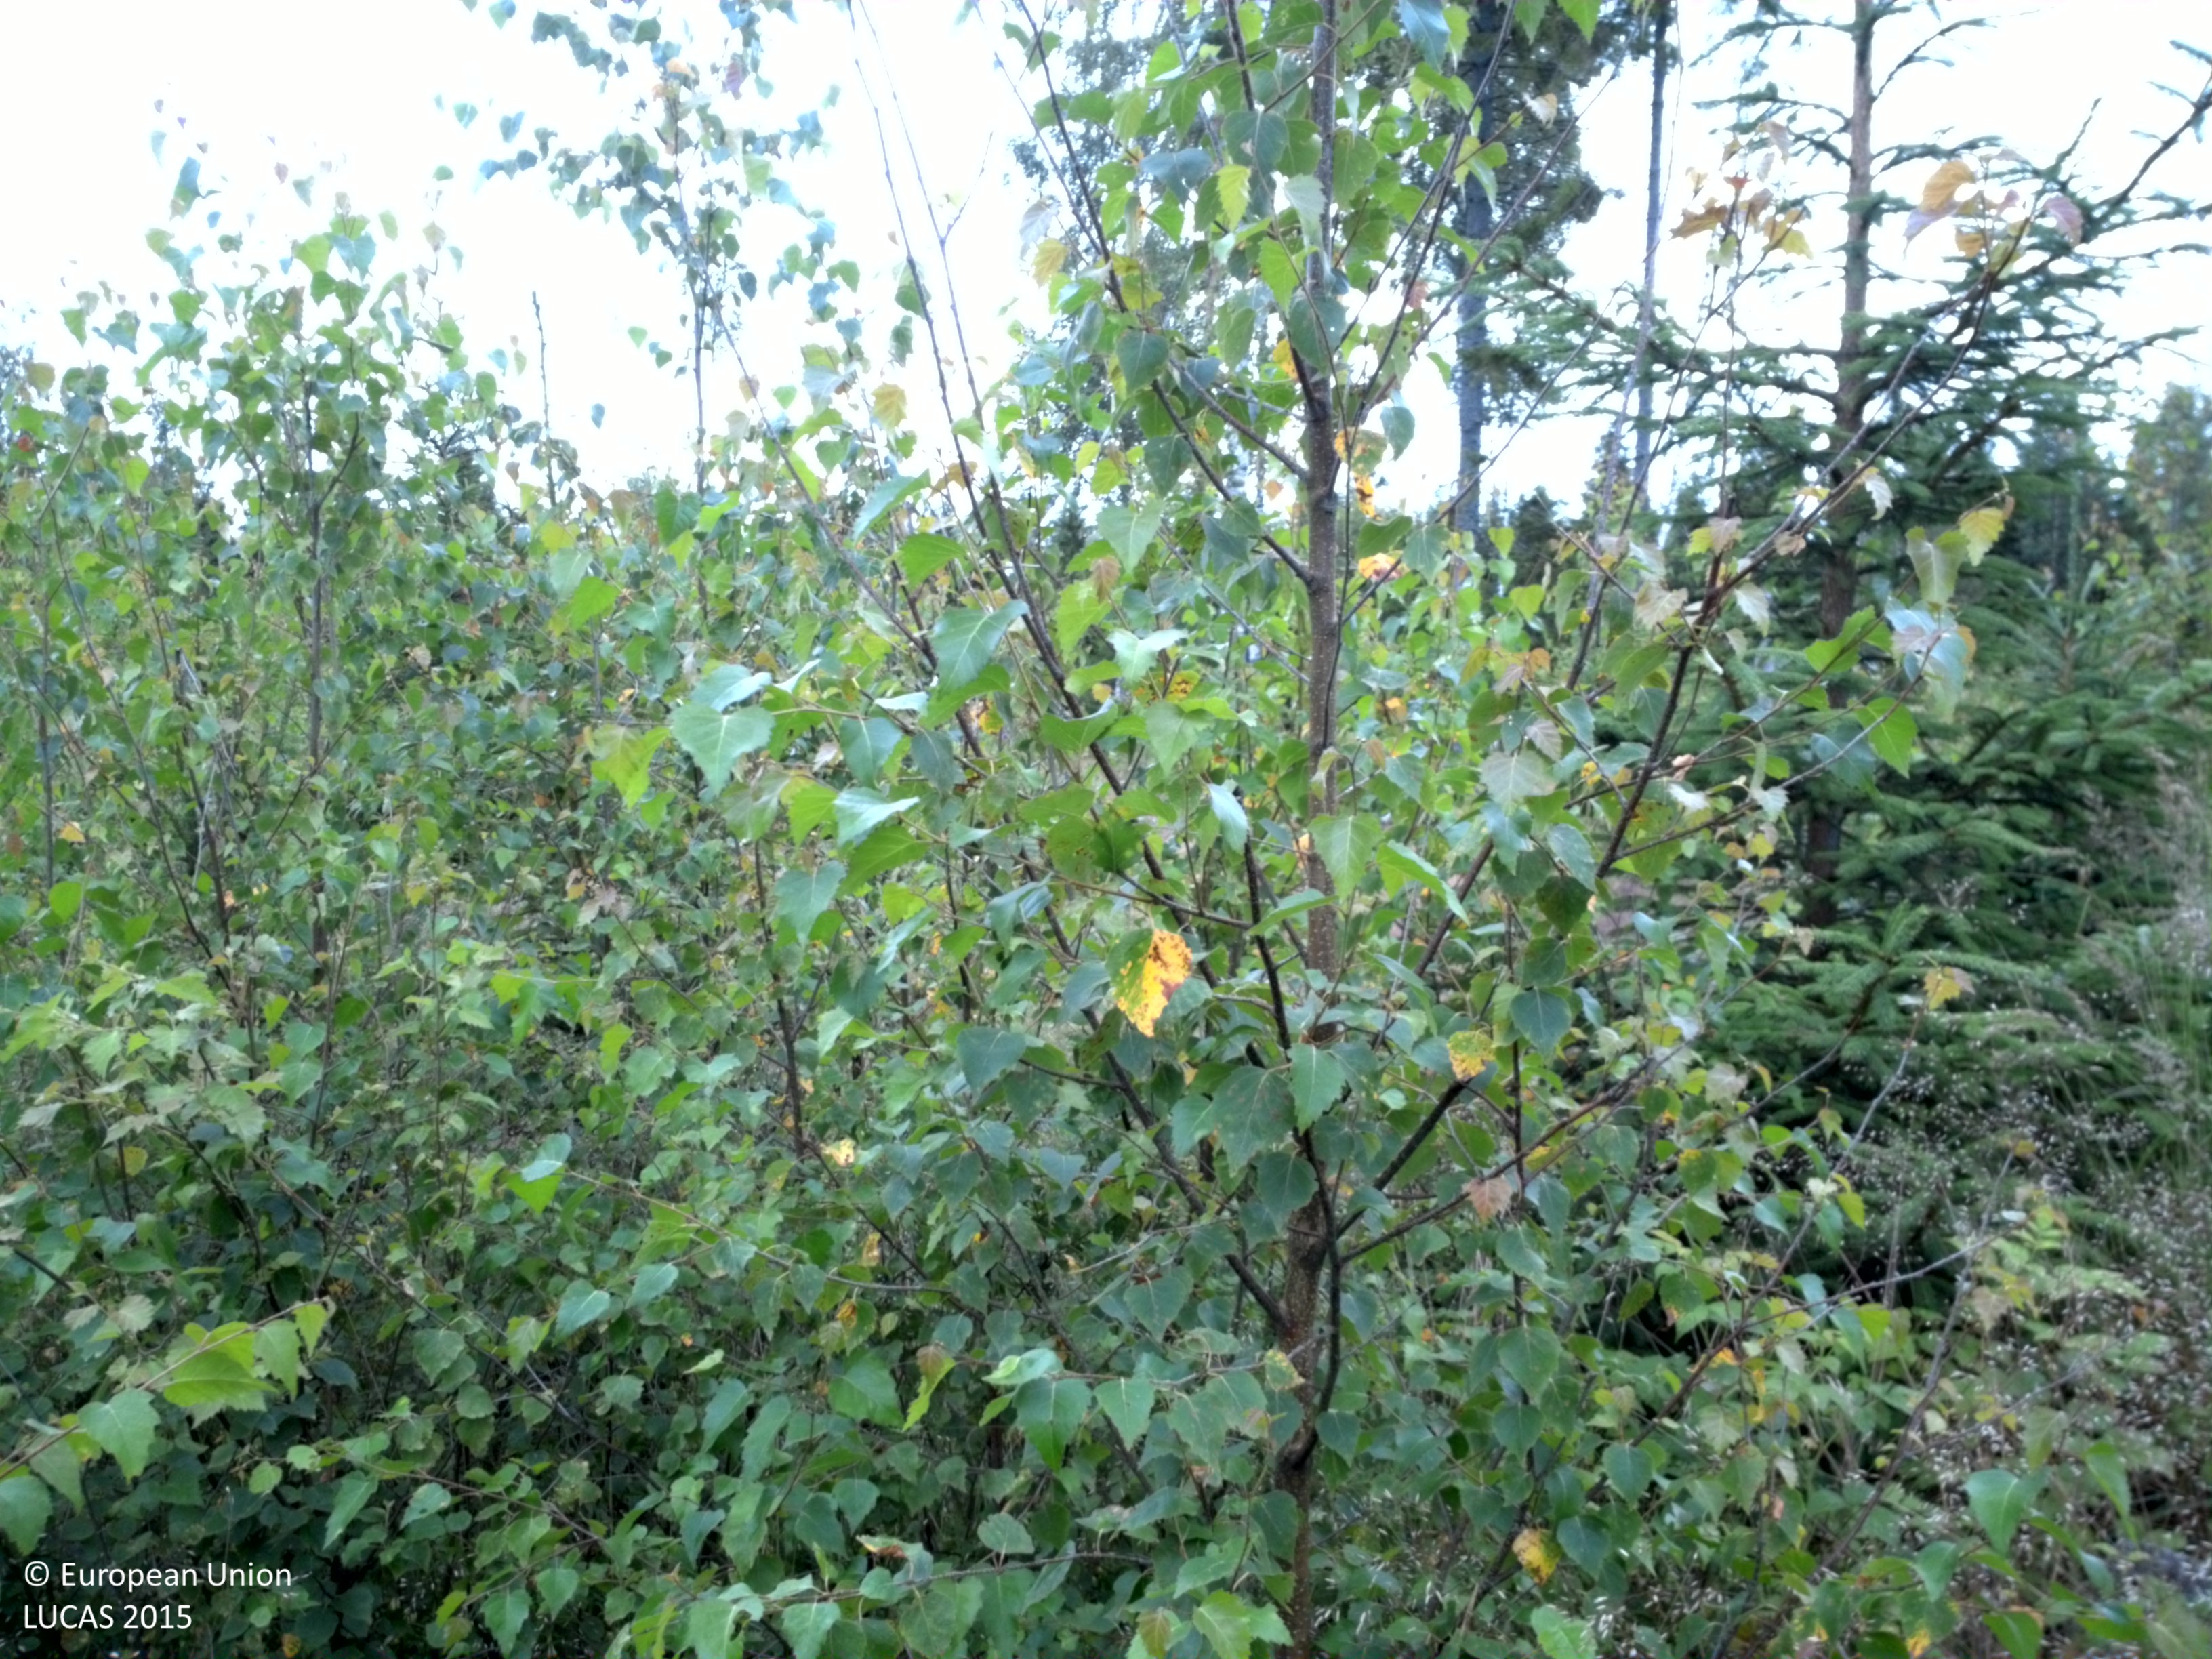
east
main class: Woodland
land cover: Spruce dominated mixed woodland
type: boreal forest
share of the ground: 50 - 75 %
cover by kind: coniferous forest trees 35 %, herbaceous plants 35 %, broadleaved forest trees 25 %, shrubs 5 %
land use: Forestry
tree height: < 5 m
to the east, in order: Spruce dominated mixed woodland; Spruce dominated coniferous woodland; Ditches and canals; Spruce dominated coniferous woodland; Paved roads, cycling and walking lanes; Spruce dominated coniferous woodland; Ditches and canals; Spruce dominated coniferous woodland
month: July
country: SE
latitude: 58.8969
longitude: 14.6265
